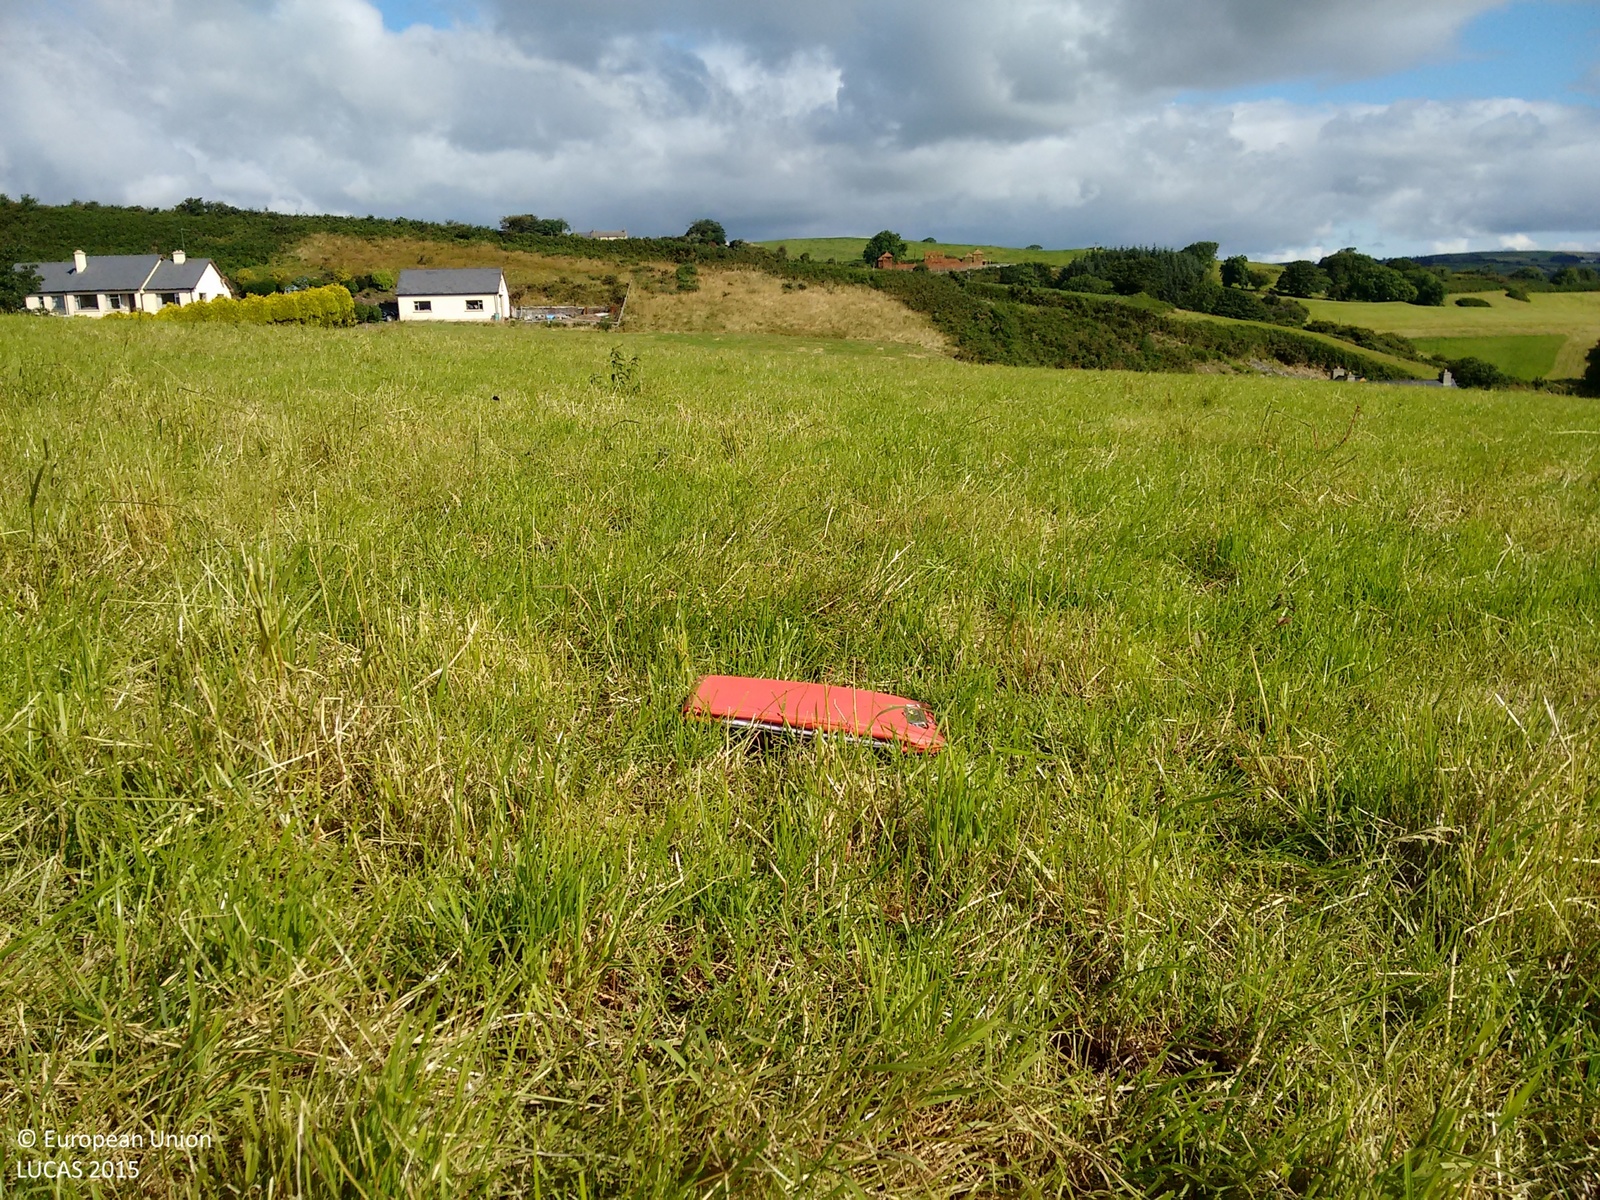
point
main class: Grassland
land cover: Grassland without tree/shrub cover
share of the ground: > 75 %
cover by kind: herbaceous plants 100 %
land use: Agriculture (excluding fallow land and kitchen gardens)
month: July
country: IE
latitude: 51.5728
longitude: -9.0437
